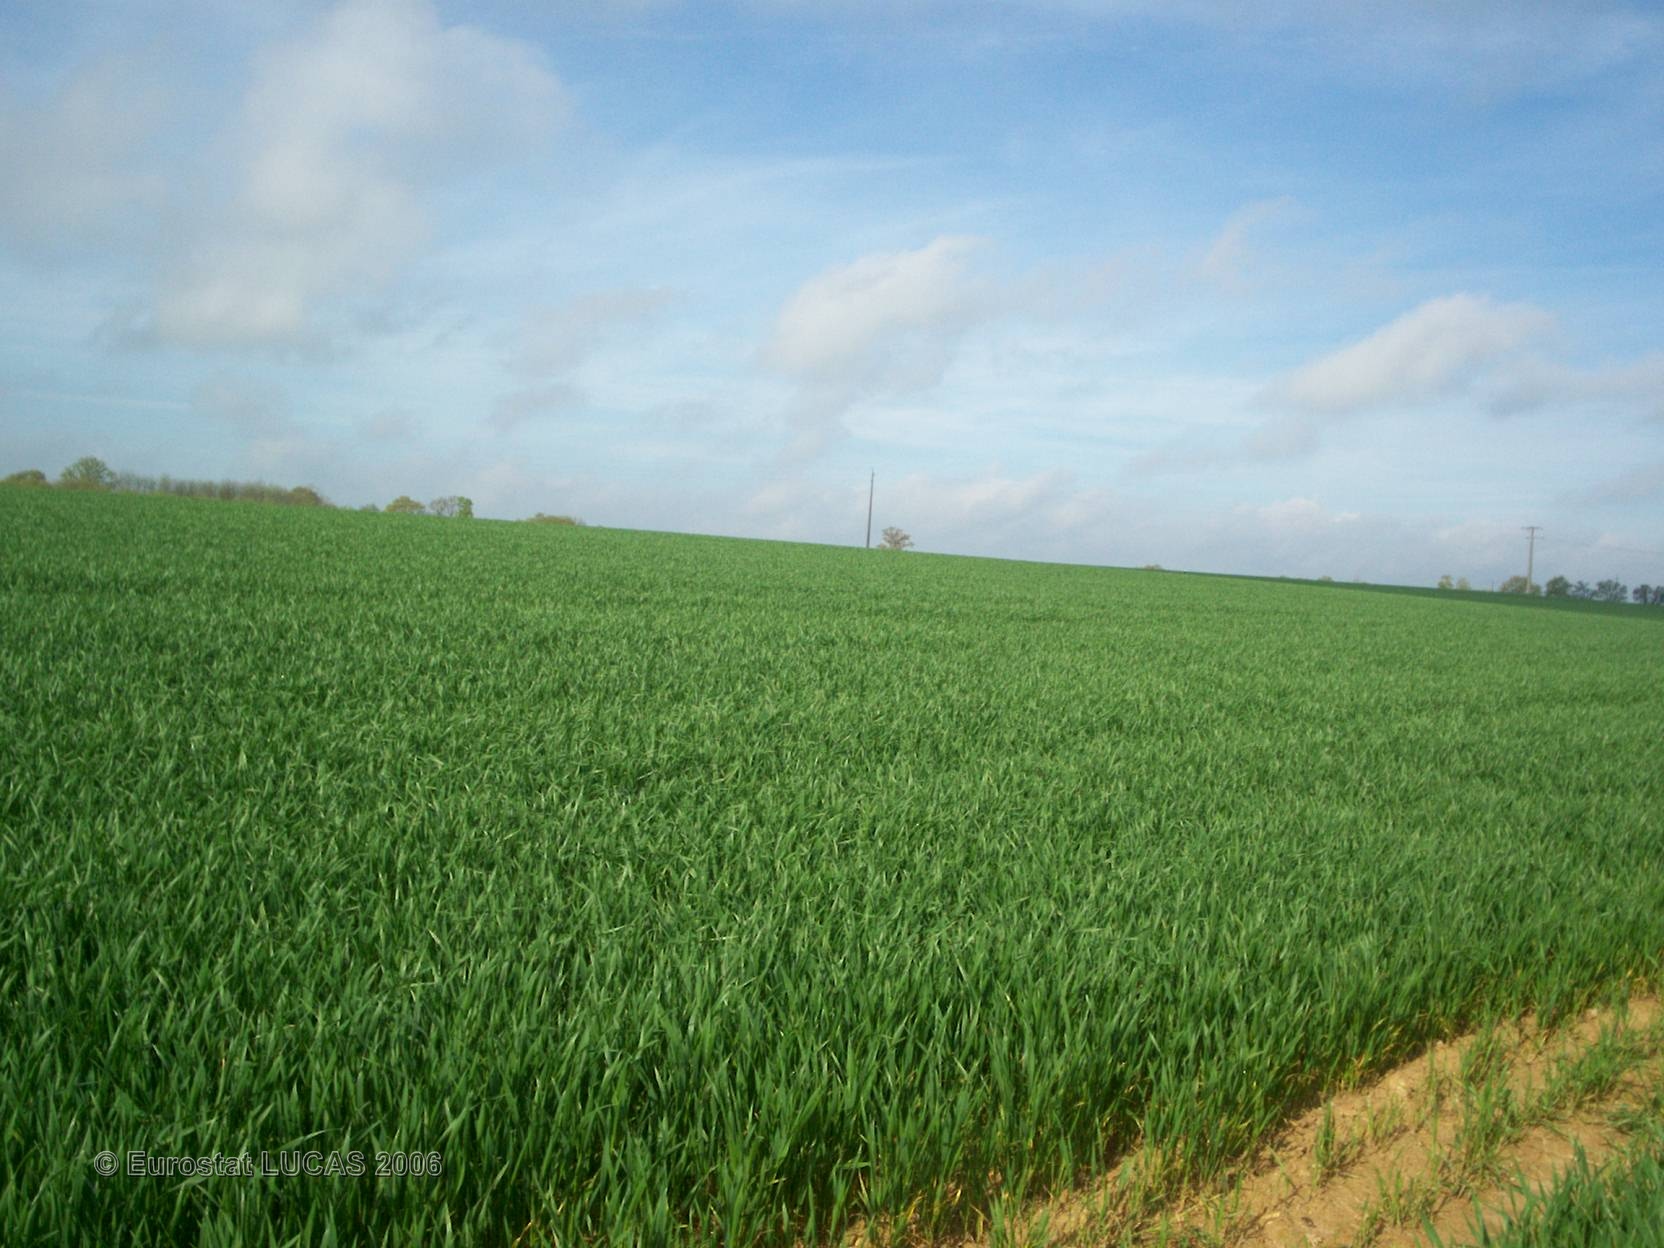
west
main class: Cropland
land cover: Common wheat
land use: Agriculture (excluding fallow land and kitchen gardens)
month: May
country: FR
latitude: 48.1250
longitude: -0.6353
